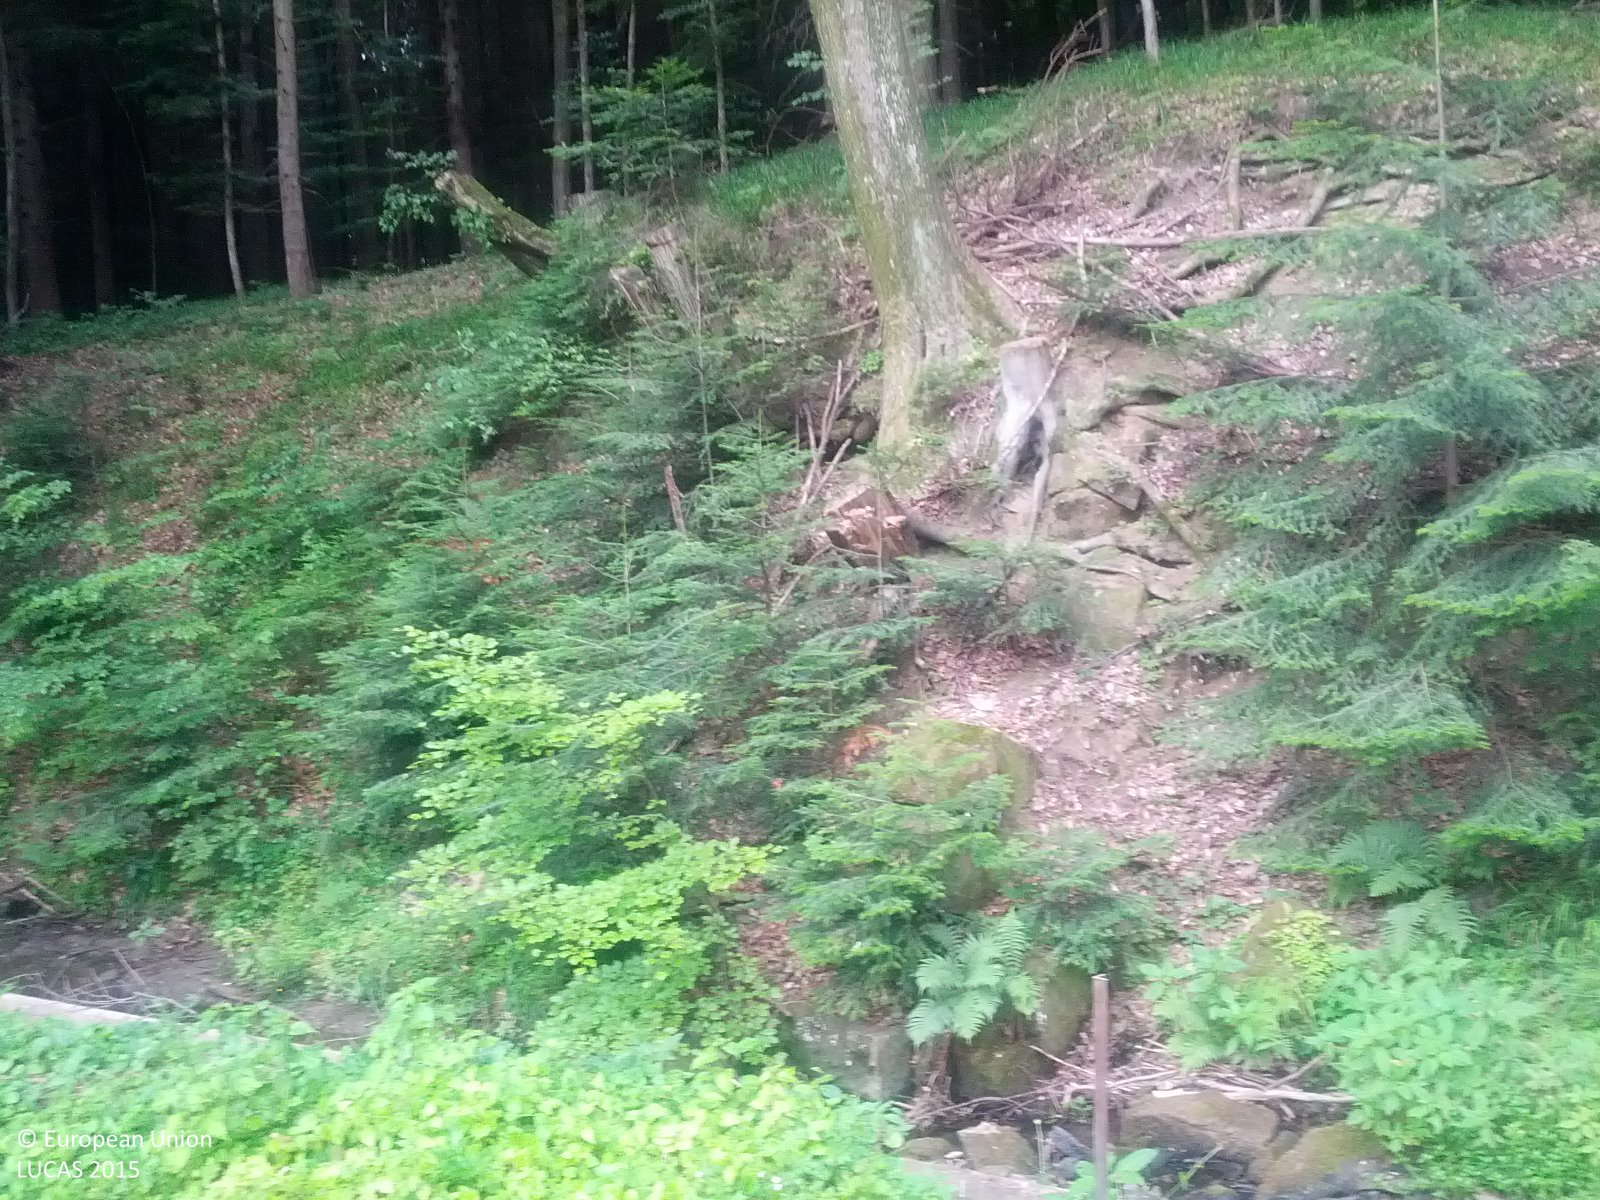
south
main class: Woodland
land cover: Spruce dominated mixed woodland
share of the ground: > 75 %
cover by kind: unconsolidated bare surface 50 %, herbaceous plants 25 %, coniferous forest trees 10 %, broadleaved forest trees 10 %, shrubs 5 %
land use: Forestry
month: June
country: AT
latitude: 48.2005
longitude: 16.0720
